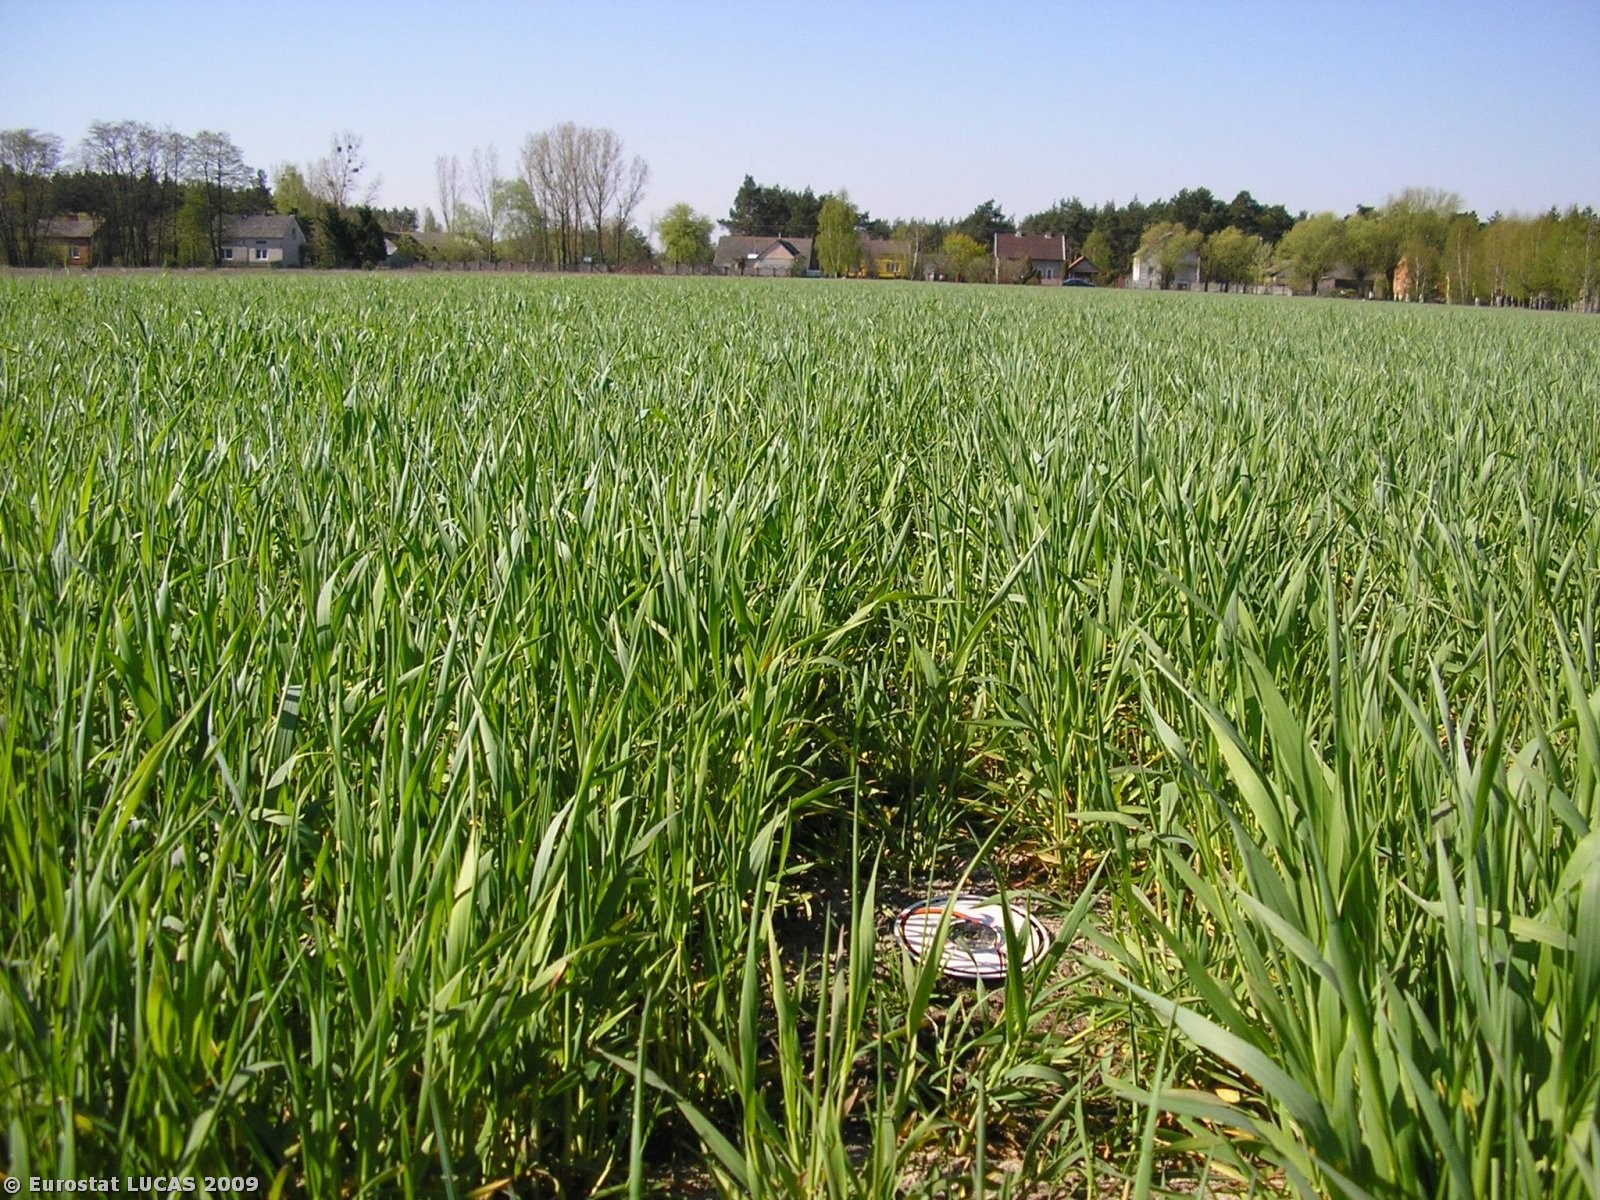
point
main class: Cropland
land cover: Rye
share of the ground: > 75 %
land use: Agriculture (excluding fallow land and kitchen gardens)
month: April
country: PL
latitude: 52.1220
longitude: 20.1561
